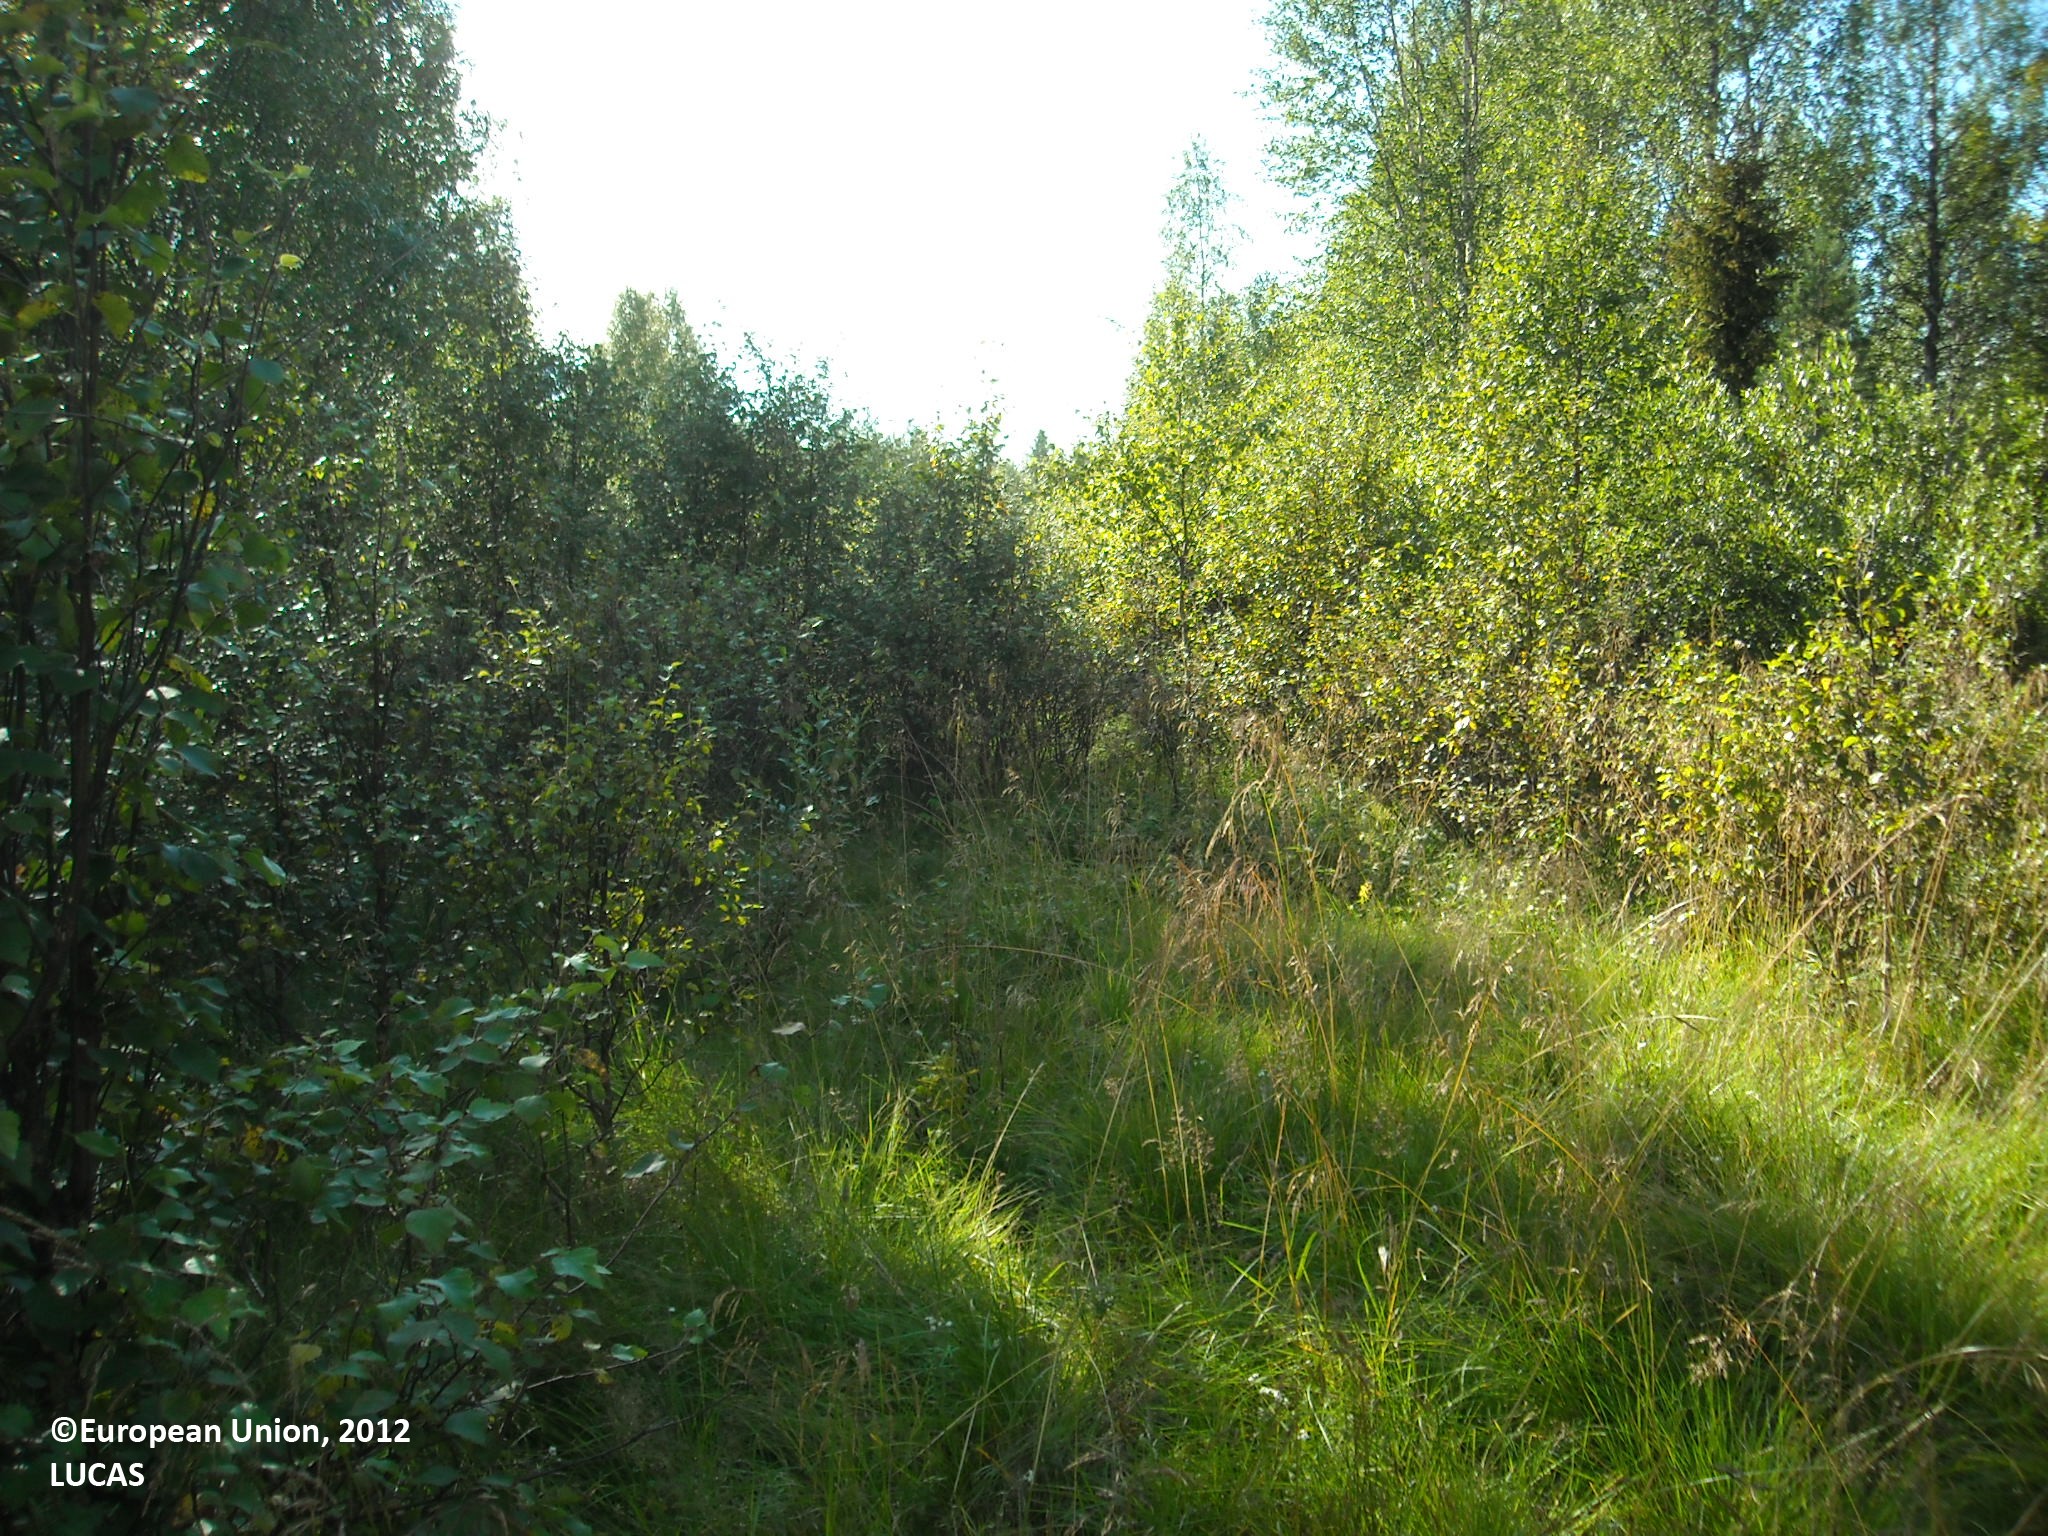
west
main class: Woodland
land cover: Broadleaved woodland
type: boreal forest
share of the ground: 50 - 75 %
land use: Forestry
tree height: > 5 m
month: August
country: FI
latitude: 65.4601
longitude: 27.8567
